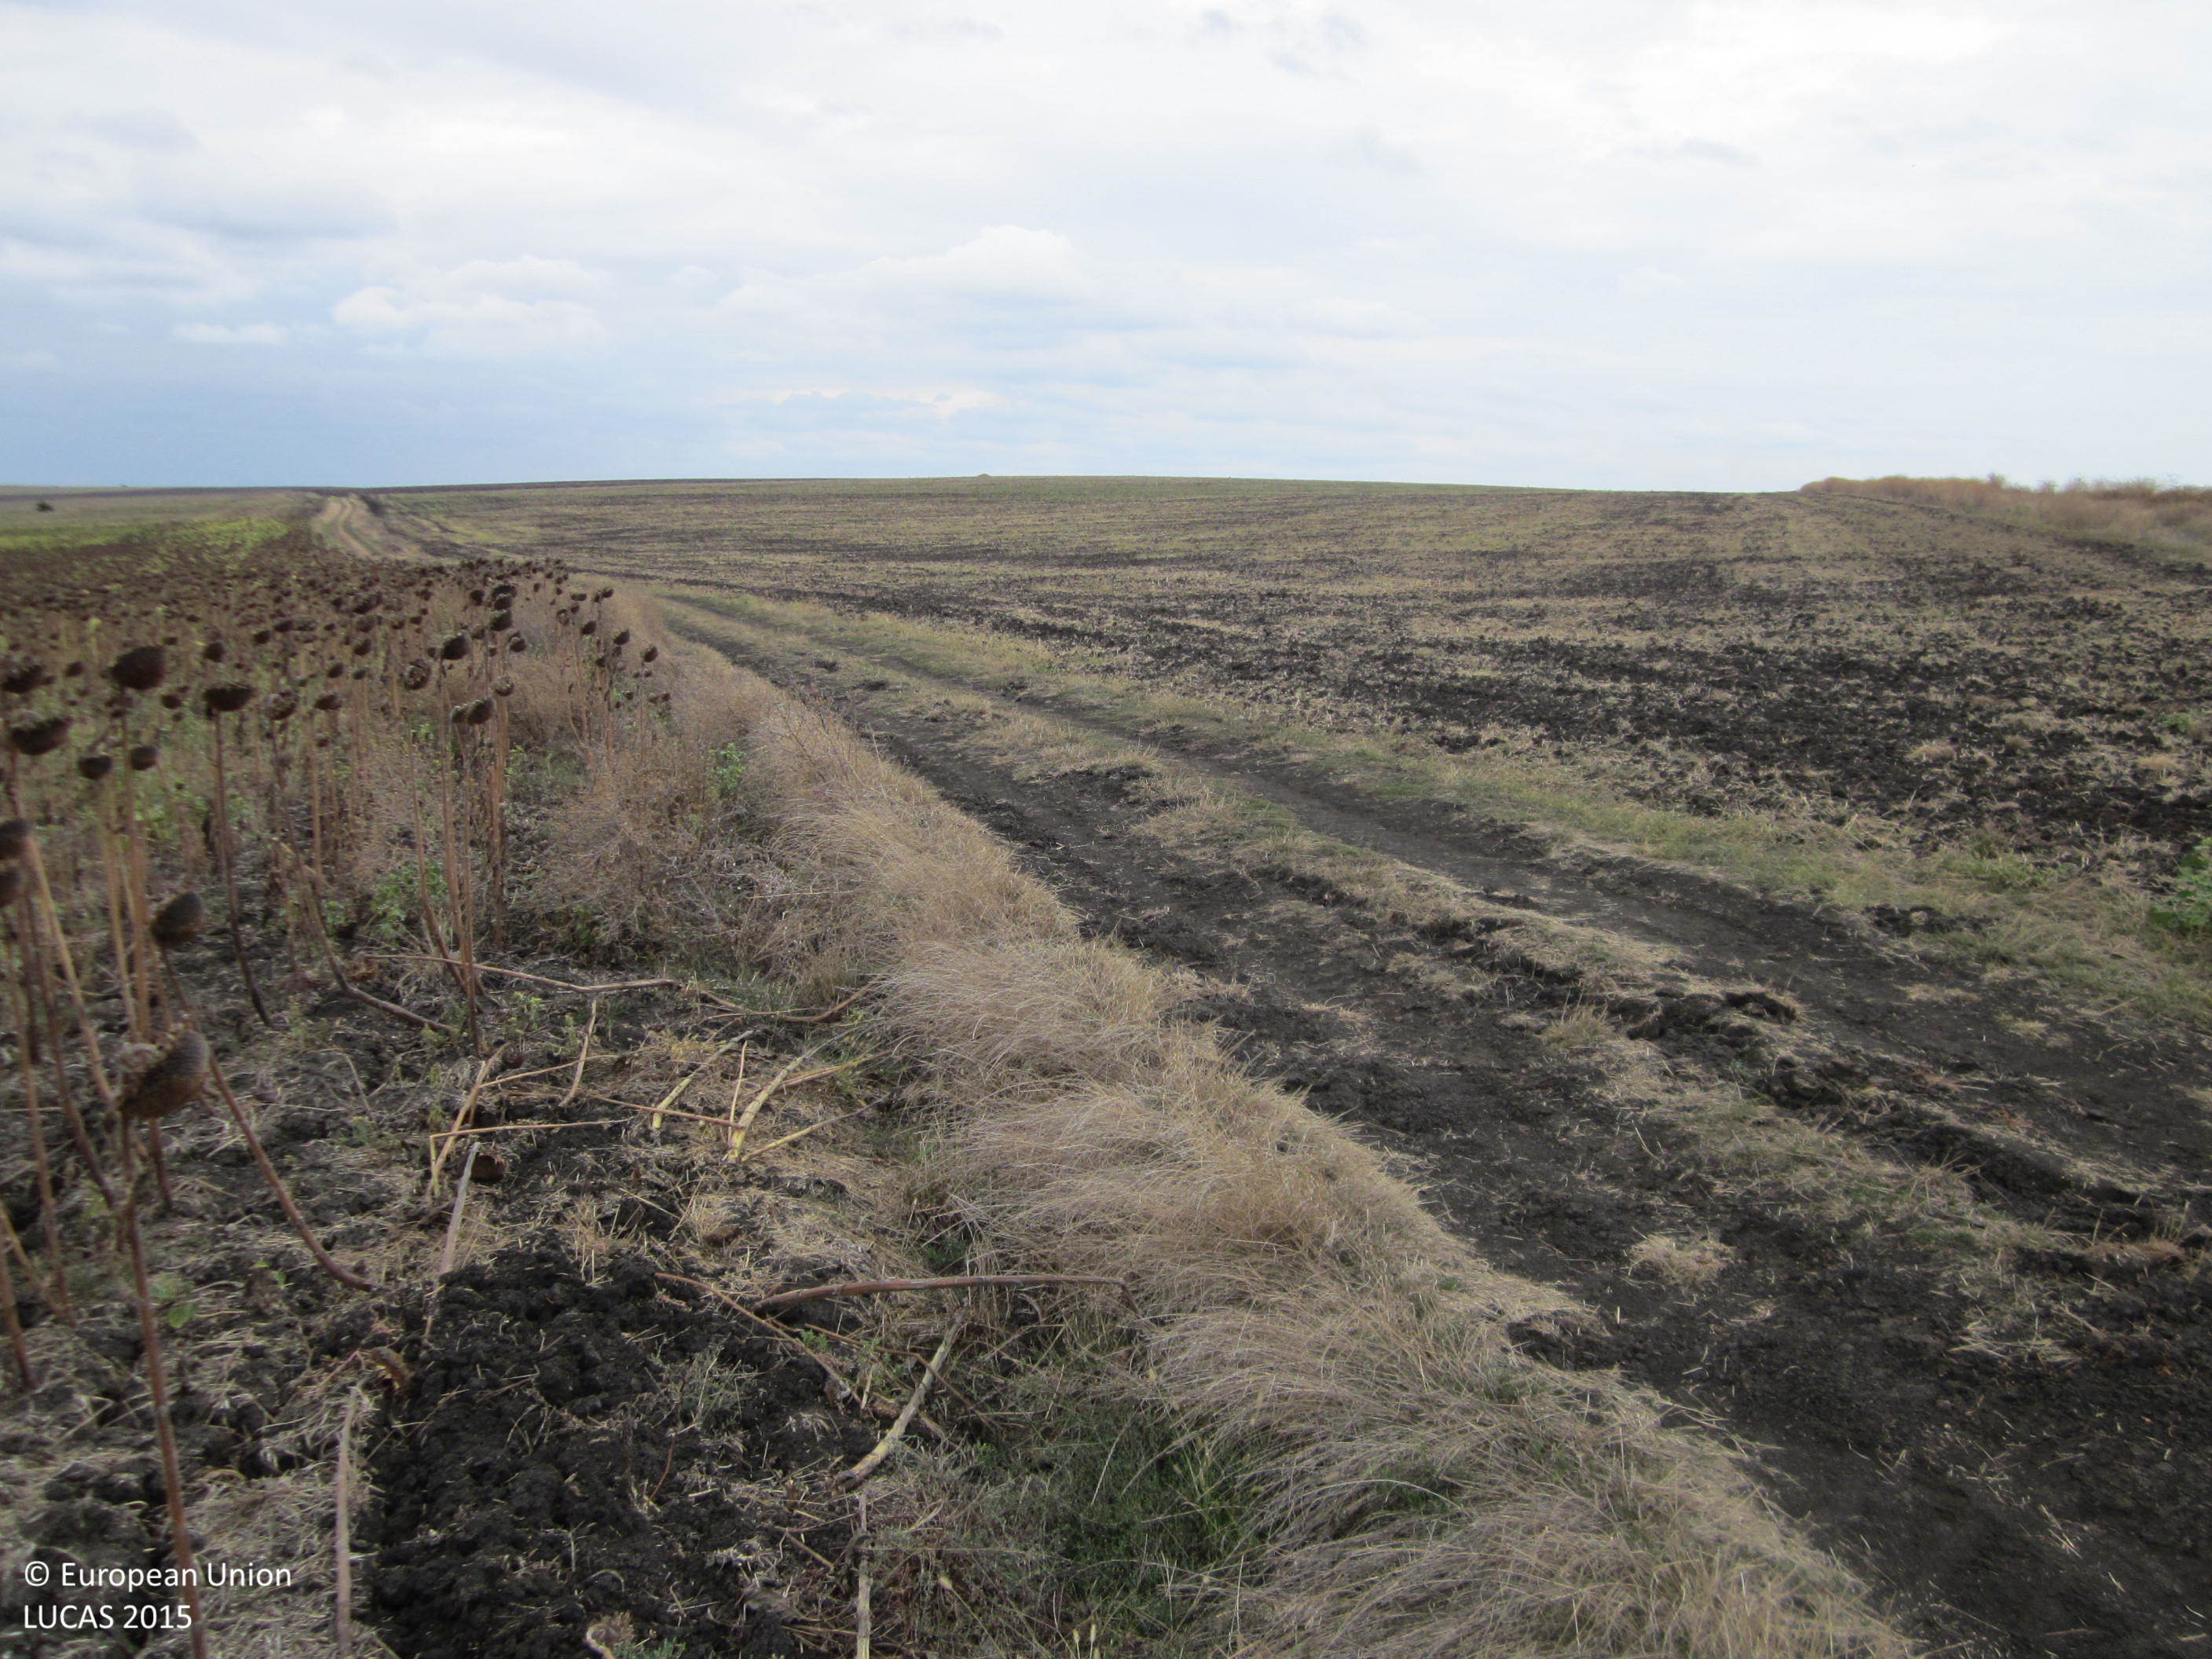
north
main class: Cropland
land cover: Sunflower
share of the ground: > 75 %
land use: Agriculture (excluding fallow land and kitchen gardens)
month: September
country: BG
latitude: 42.4734
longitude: 27.2239
